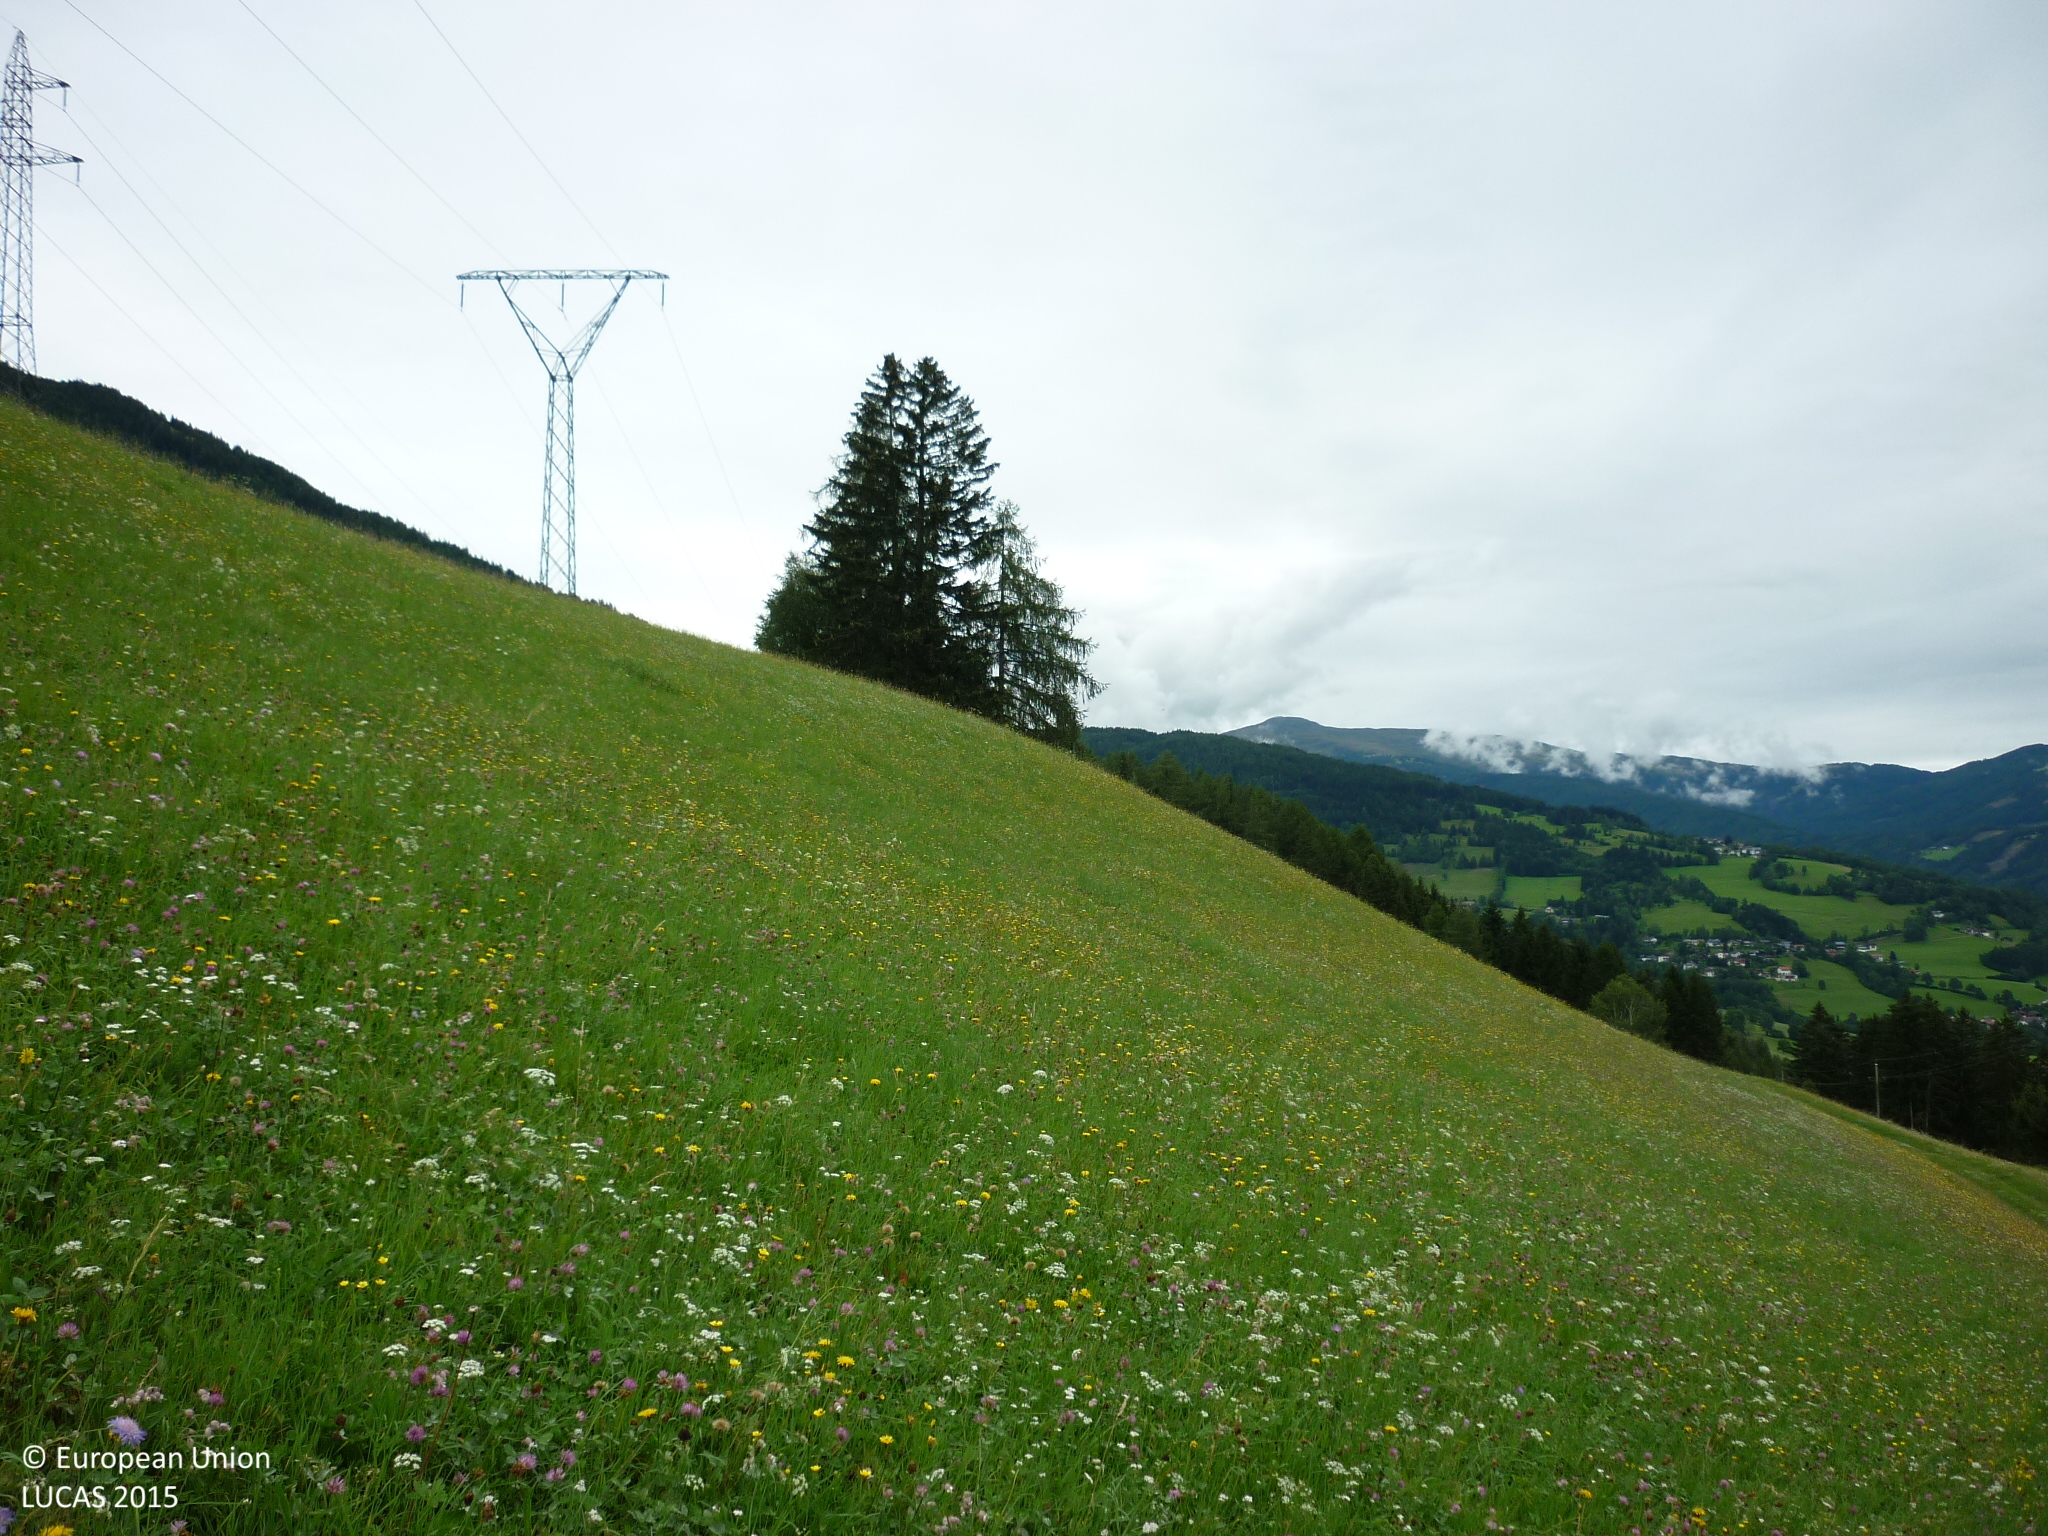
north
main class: Grassland
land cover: Grassland without tree/shrub cover
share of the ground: > 75 %
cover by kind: herbaceous plants 100 %
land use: Agriculture (excluding fallow land and kitchen gardens)
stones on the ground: < 10 %
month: August
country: AT
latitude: 46.8708
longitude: 13.5005
